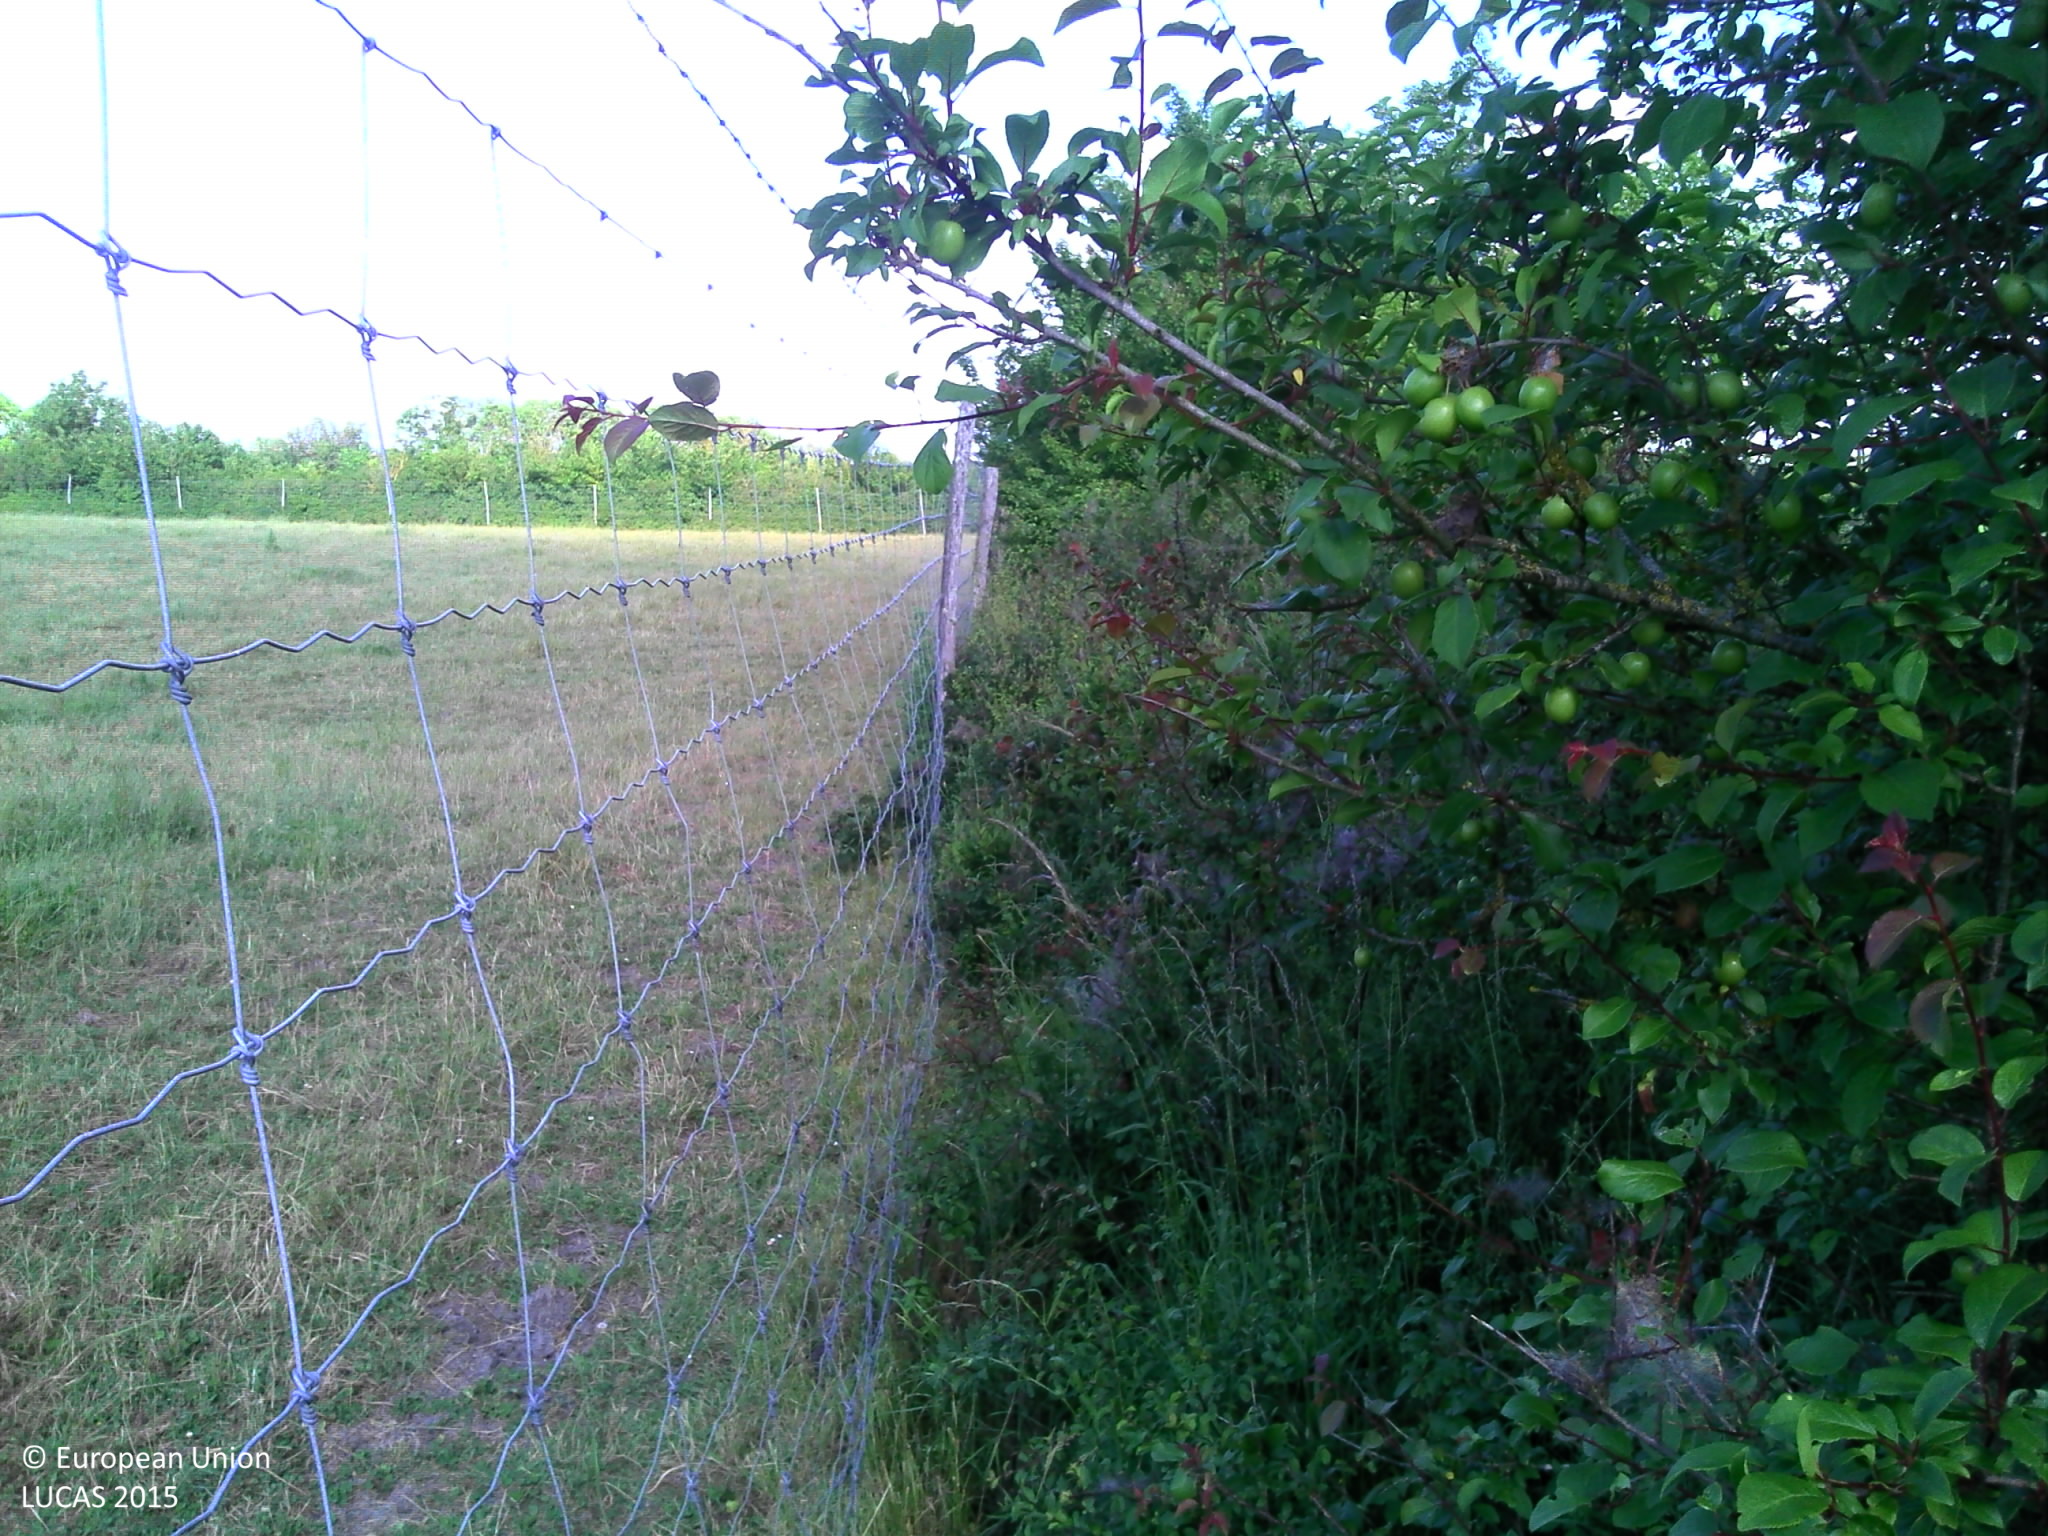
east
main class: Grassland
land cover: Grassland without tree/shrub cover
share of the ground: > 75 %
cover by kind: herbaceous plants 100 %
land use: Agriculture (excluding fallow land and kitchen gardens)
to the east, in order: Grassland without tree/shrub cover; Abandoned hedges; Fences; Ditches and canals; Maize; Abandoned hedges; Ditches and canals; Grass margins; Durum wheat
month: June
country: FR
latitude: 46.2731
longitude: -0.9958
